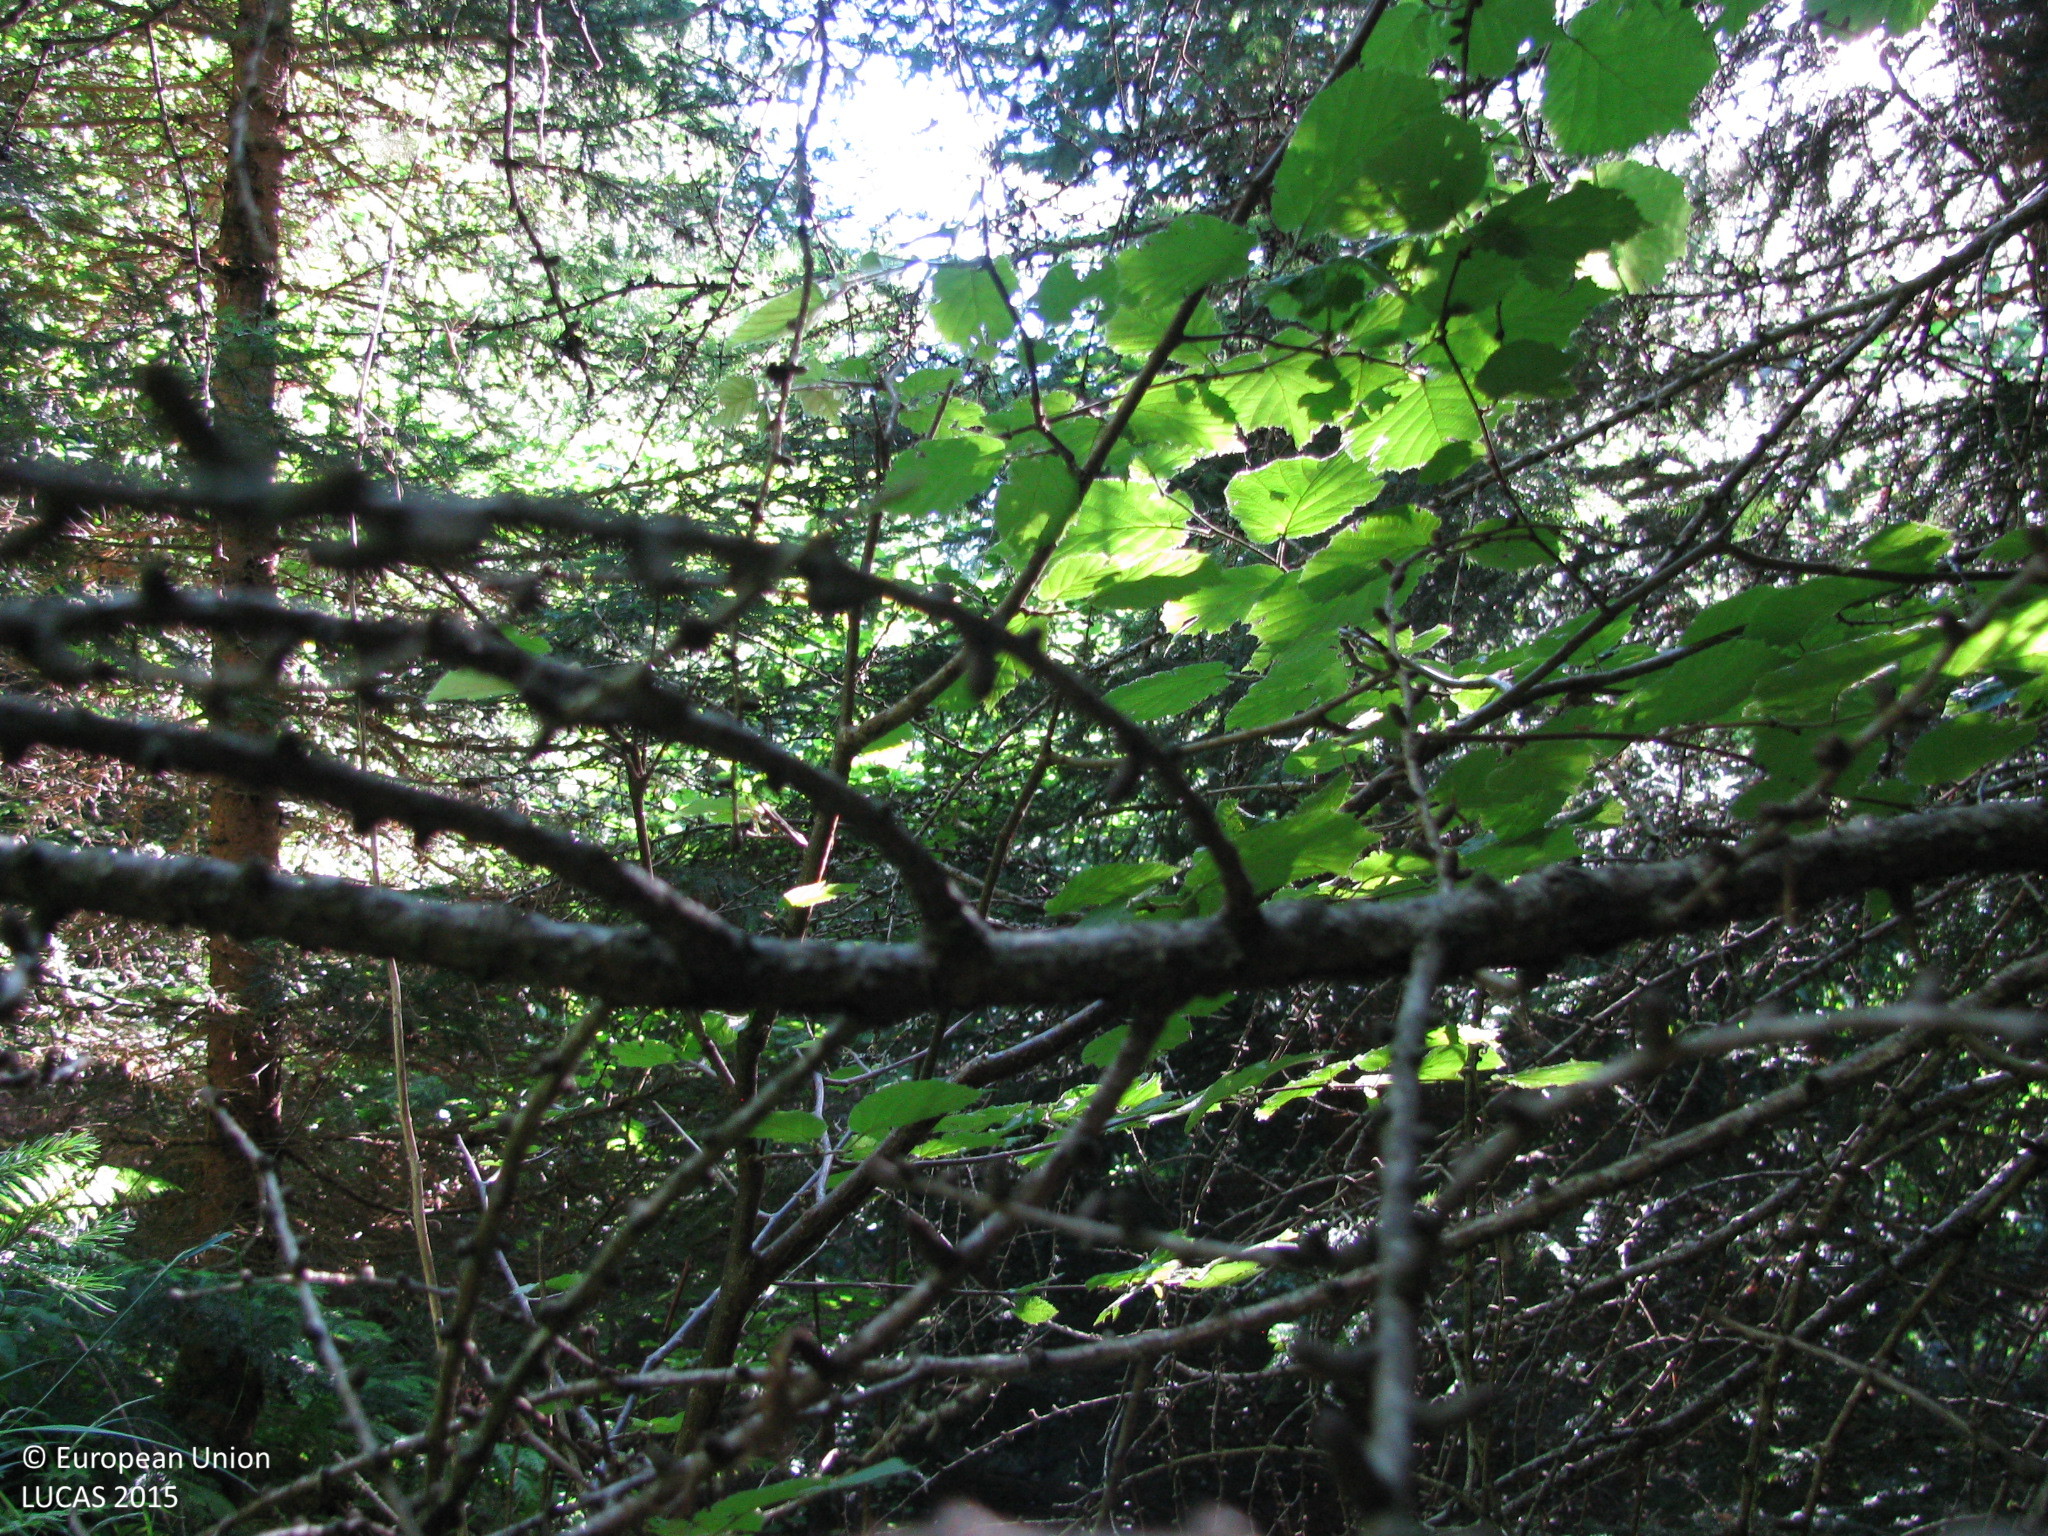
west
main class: Woodland
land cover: Spruce dominated coniferous woodland
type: alpine coniferous forest
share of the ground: > 75 %
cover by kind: coniferous forest trees 80 %, herbaceous plants 15 %, shrubs 5 %
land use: Forestry
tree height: > 5 m
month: July
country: AT
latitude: 47.2467
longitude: 14.9538
